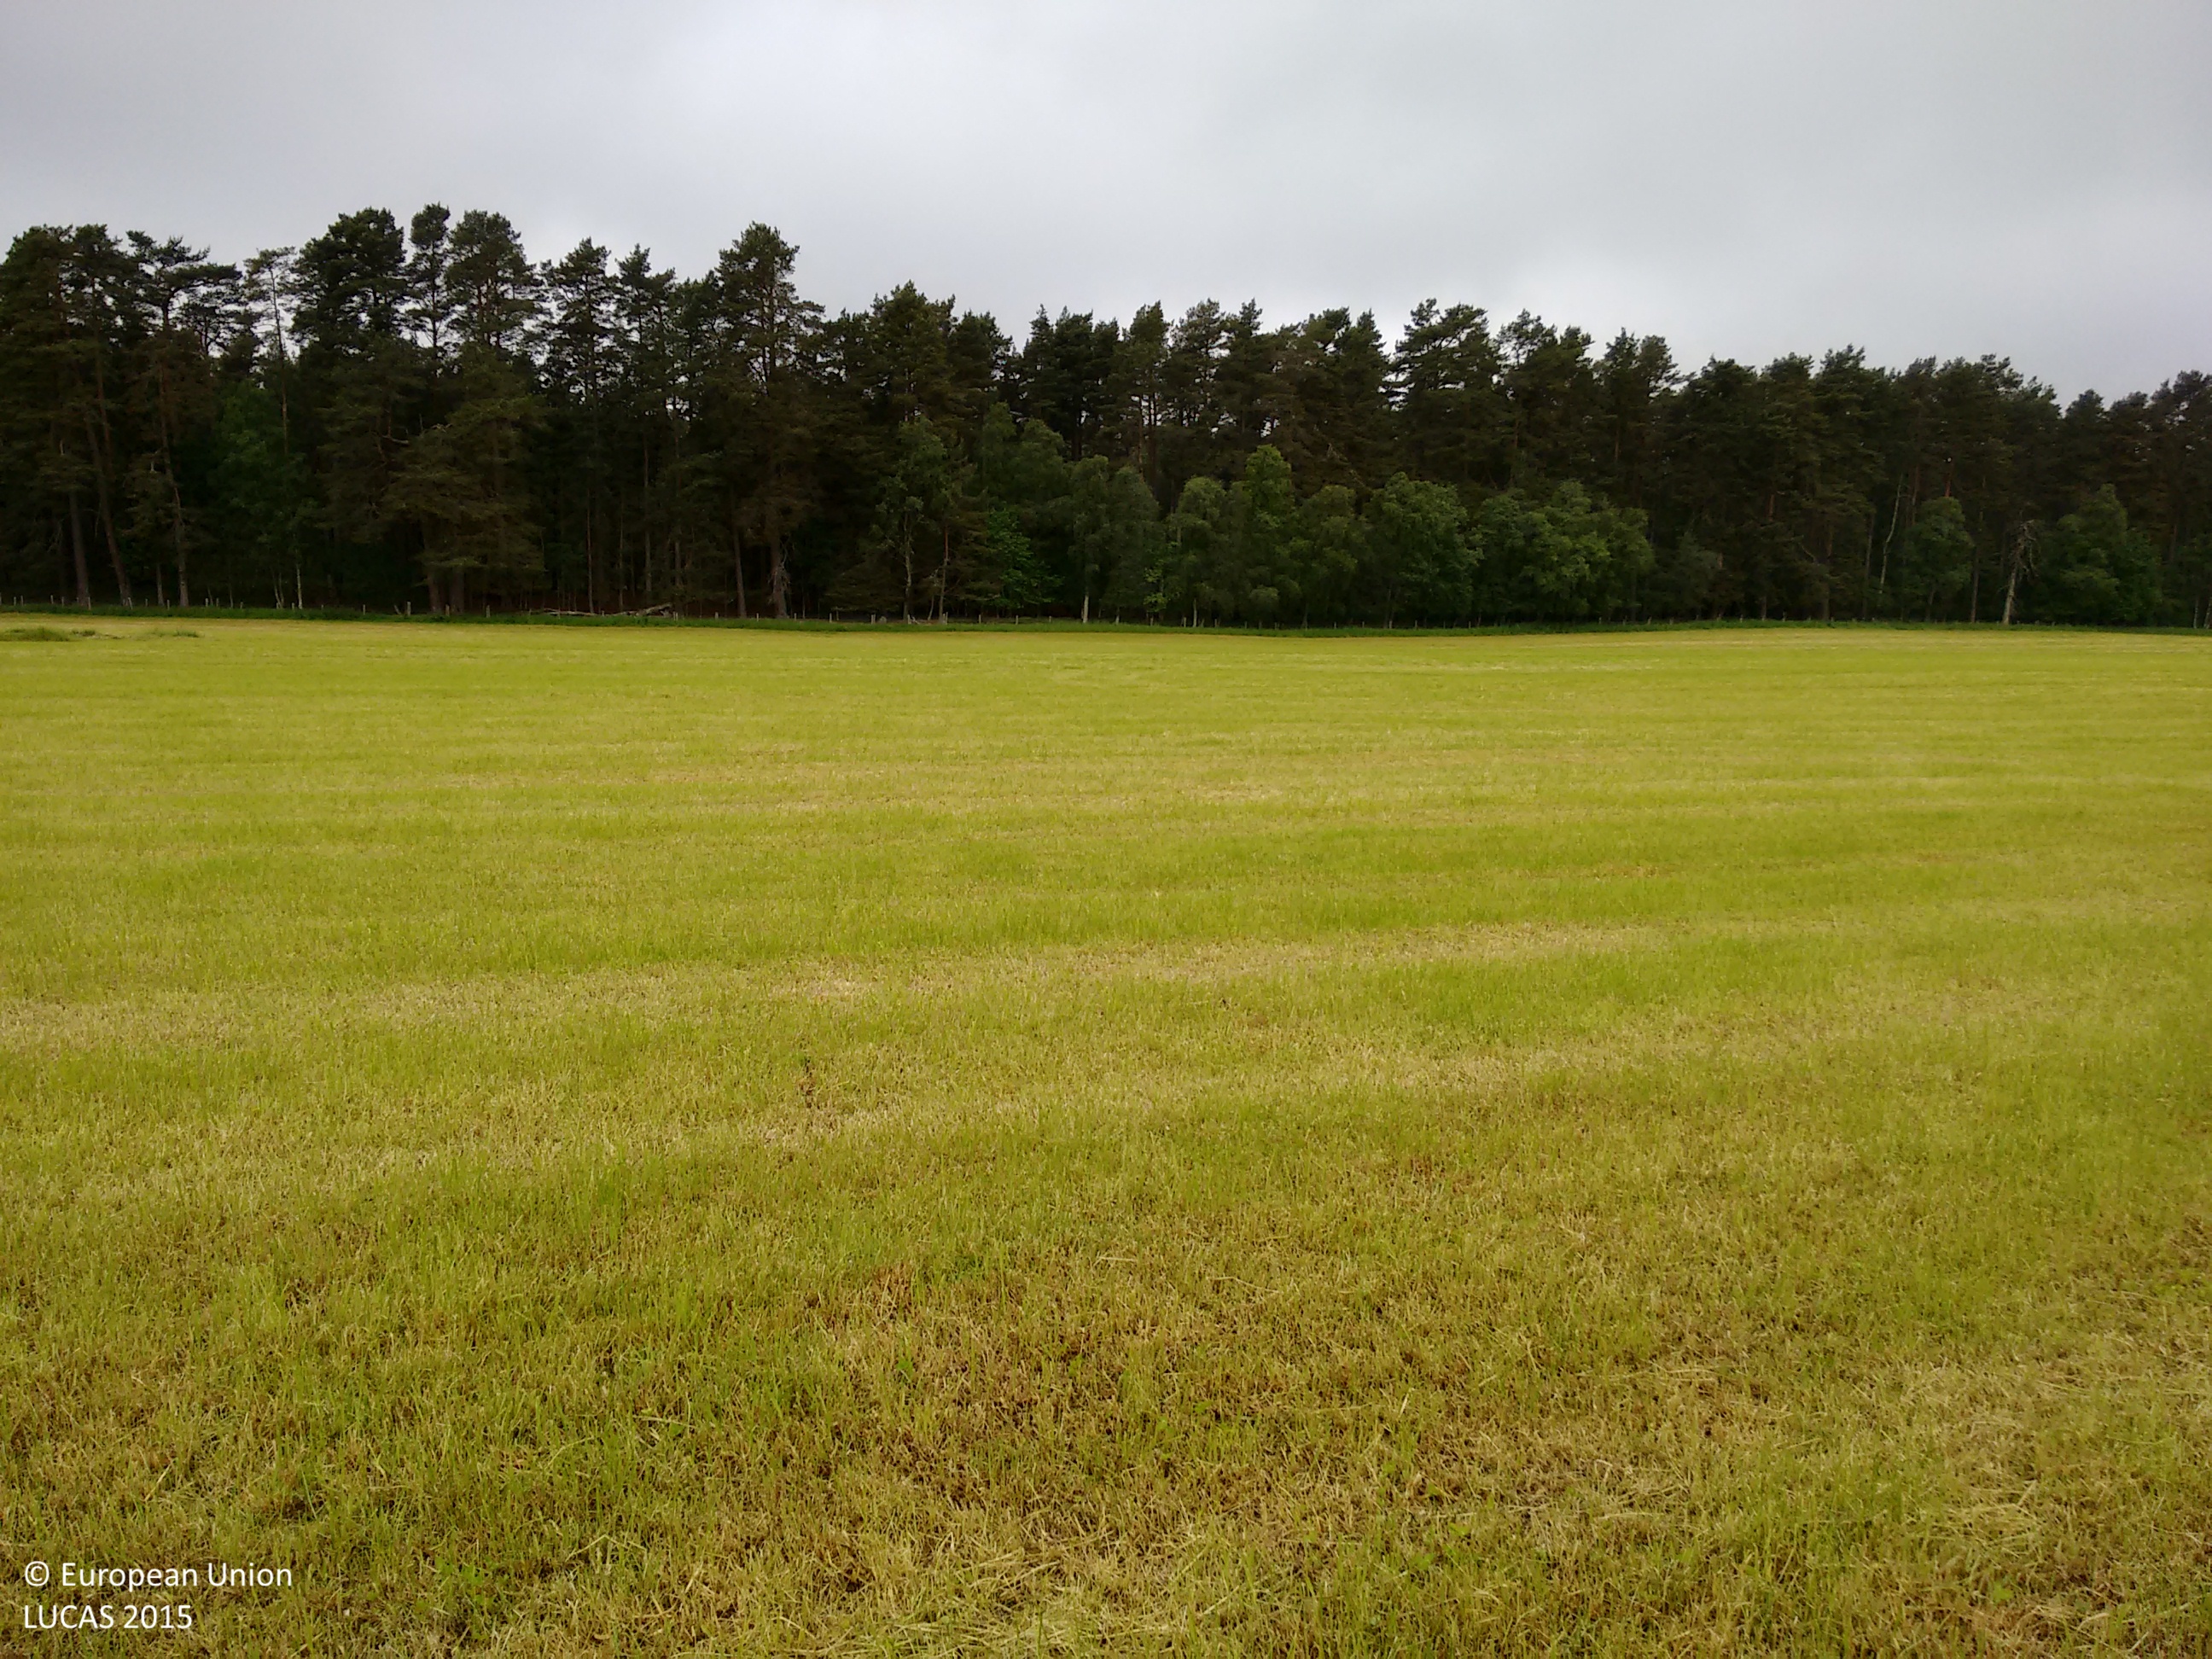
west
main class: Grassland
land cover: Grassland without tree/shrub cover
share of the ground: > 75 %
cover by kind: herbaceous plants 100 %
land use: Agriculture (excluding fallow land and kitchen gardens)
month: June
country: GB
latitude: 57.1173
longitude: -2.9267
